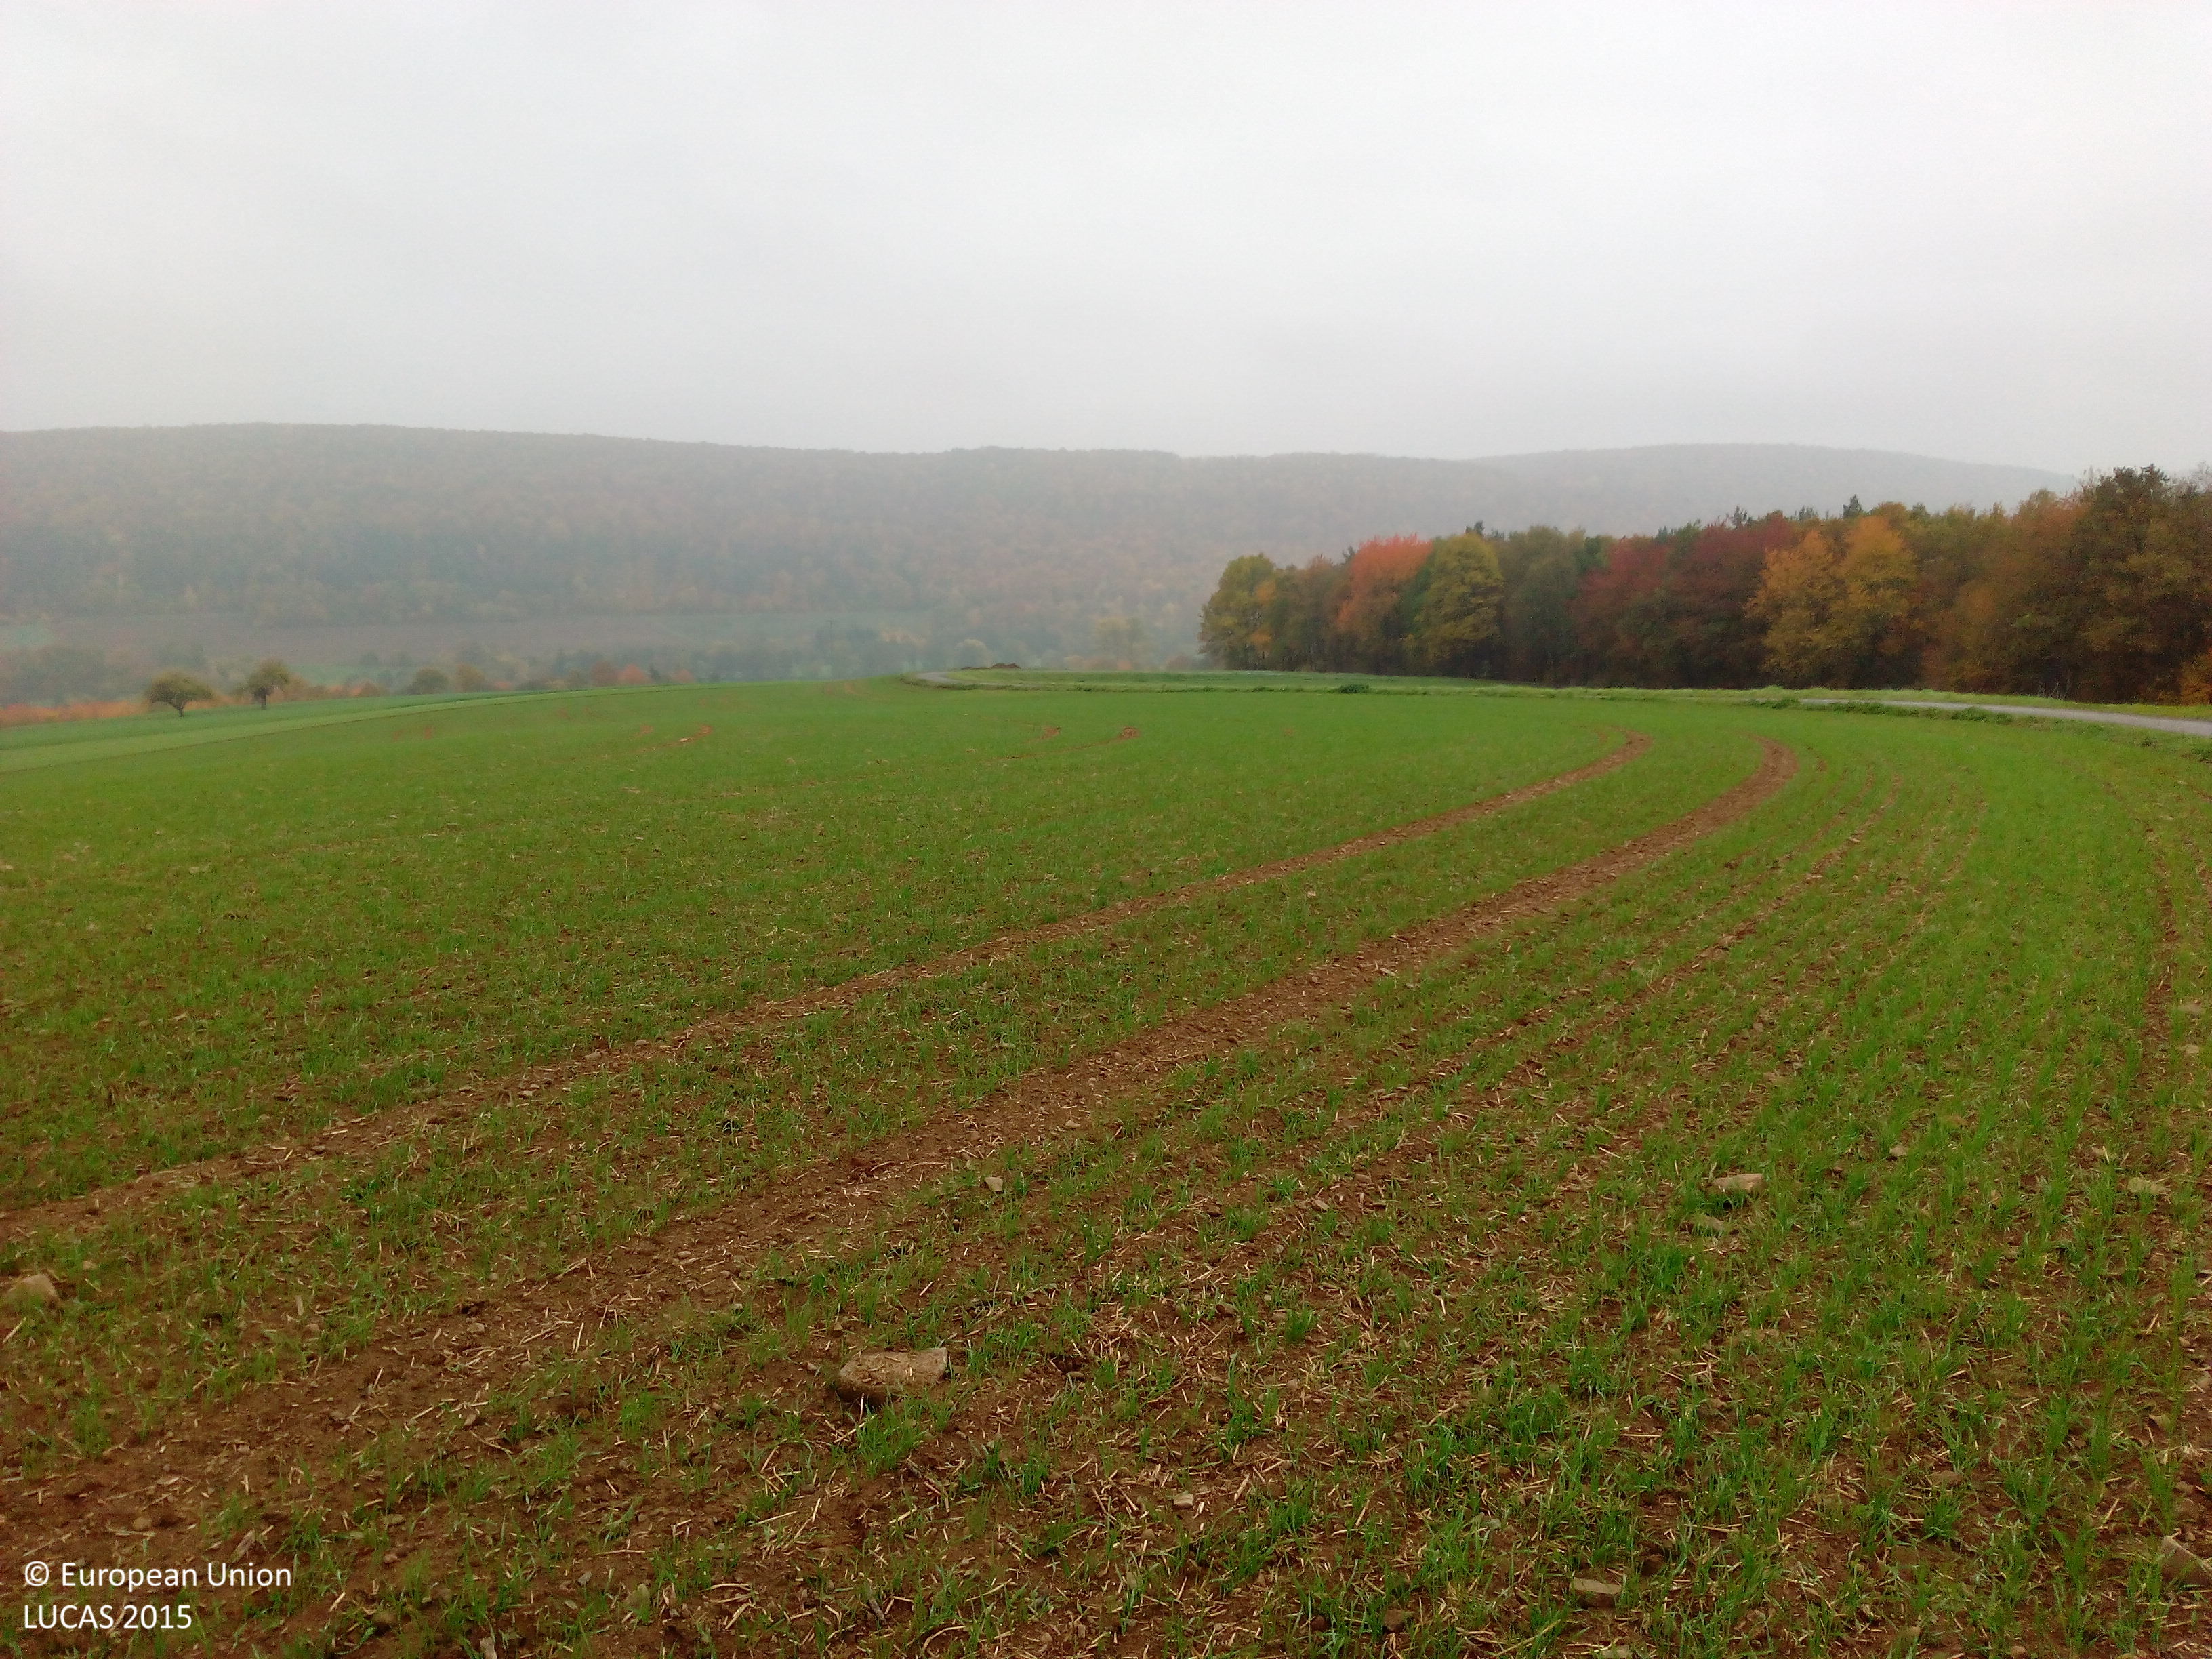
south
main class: Cropland
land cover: Common wheat
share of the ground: < 10 %
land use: Agriculture (excluding fallow land and kitchen gardens)
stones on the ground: 10 - 25 %
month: October
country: DE
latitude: 50.1662
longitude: 9.9020
